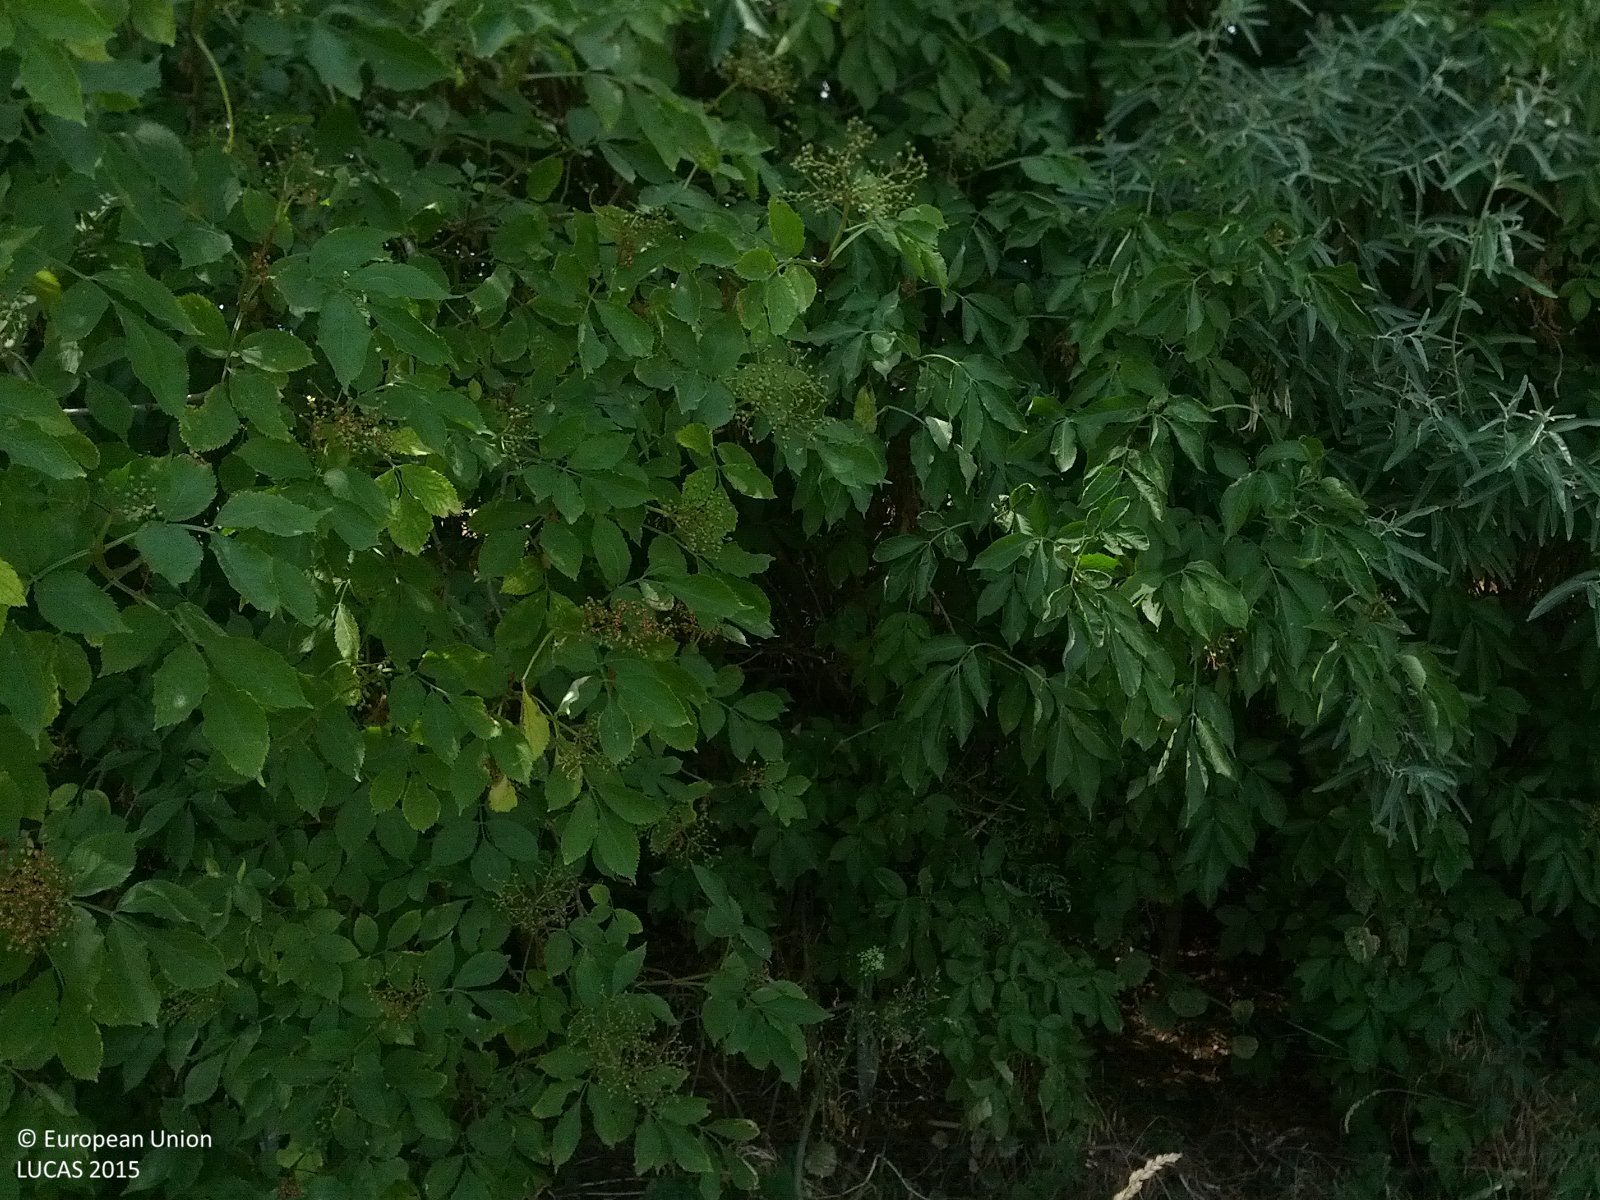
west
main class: Cropland
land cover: Barley
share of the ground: > 75 %
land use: Agriculture (excluding fallow land and kitchen gardens)
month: June
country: AT
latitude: 48.6792
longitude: 16.8393
